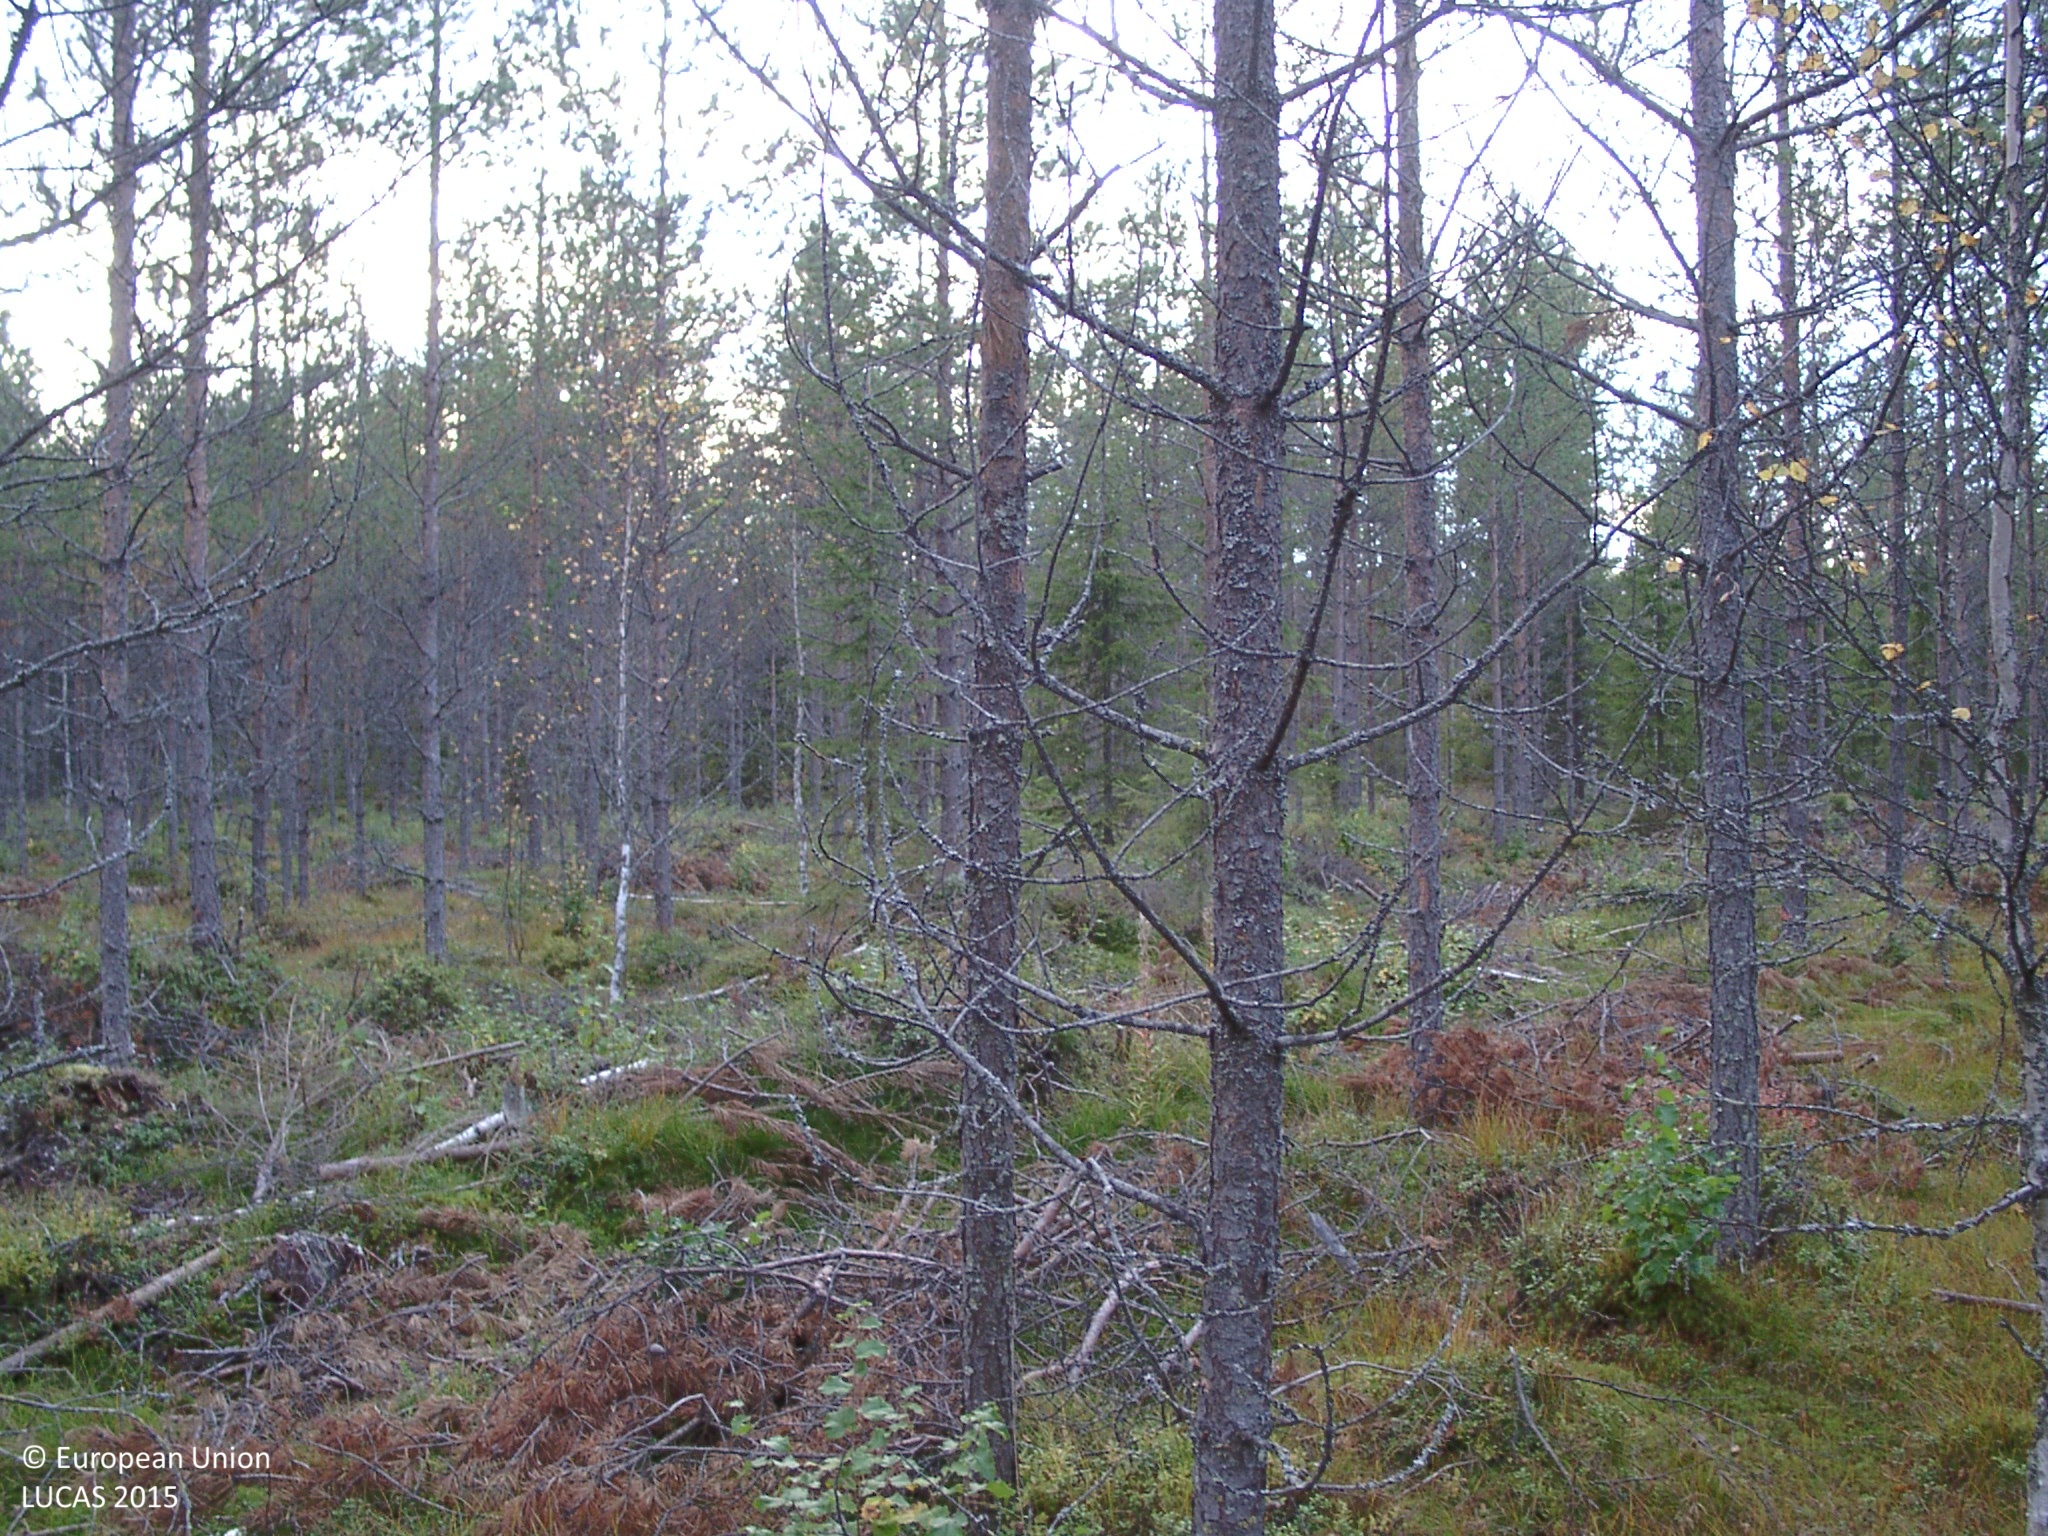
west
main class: Woodland
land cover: Pine dominated coniferous woodland
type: boreal forest
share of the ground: 25 - 50 %
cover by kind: coniferous forest trees 35 %, lichens and mosses 25 %, shrubs 15 %, herbaceous plants 15 %, broadleaved forest trees 5 %
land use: Forestry
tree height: > 5 m
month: September
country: FI
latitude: 62.5240
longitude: 25.1207
